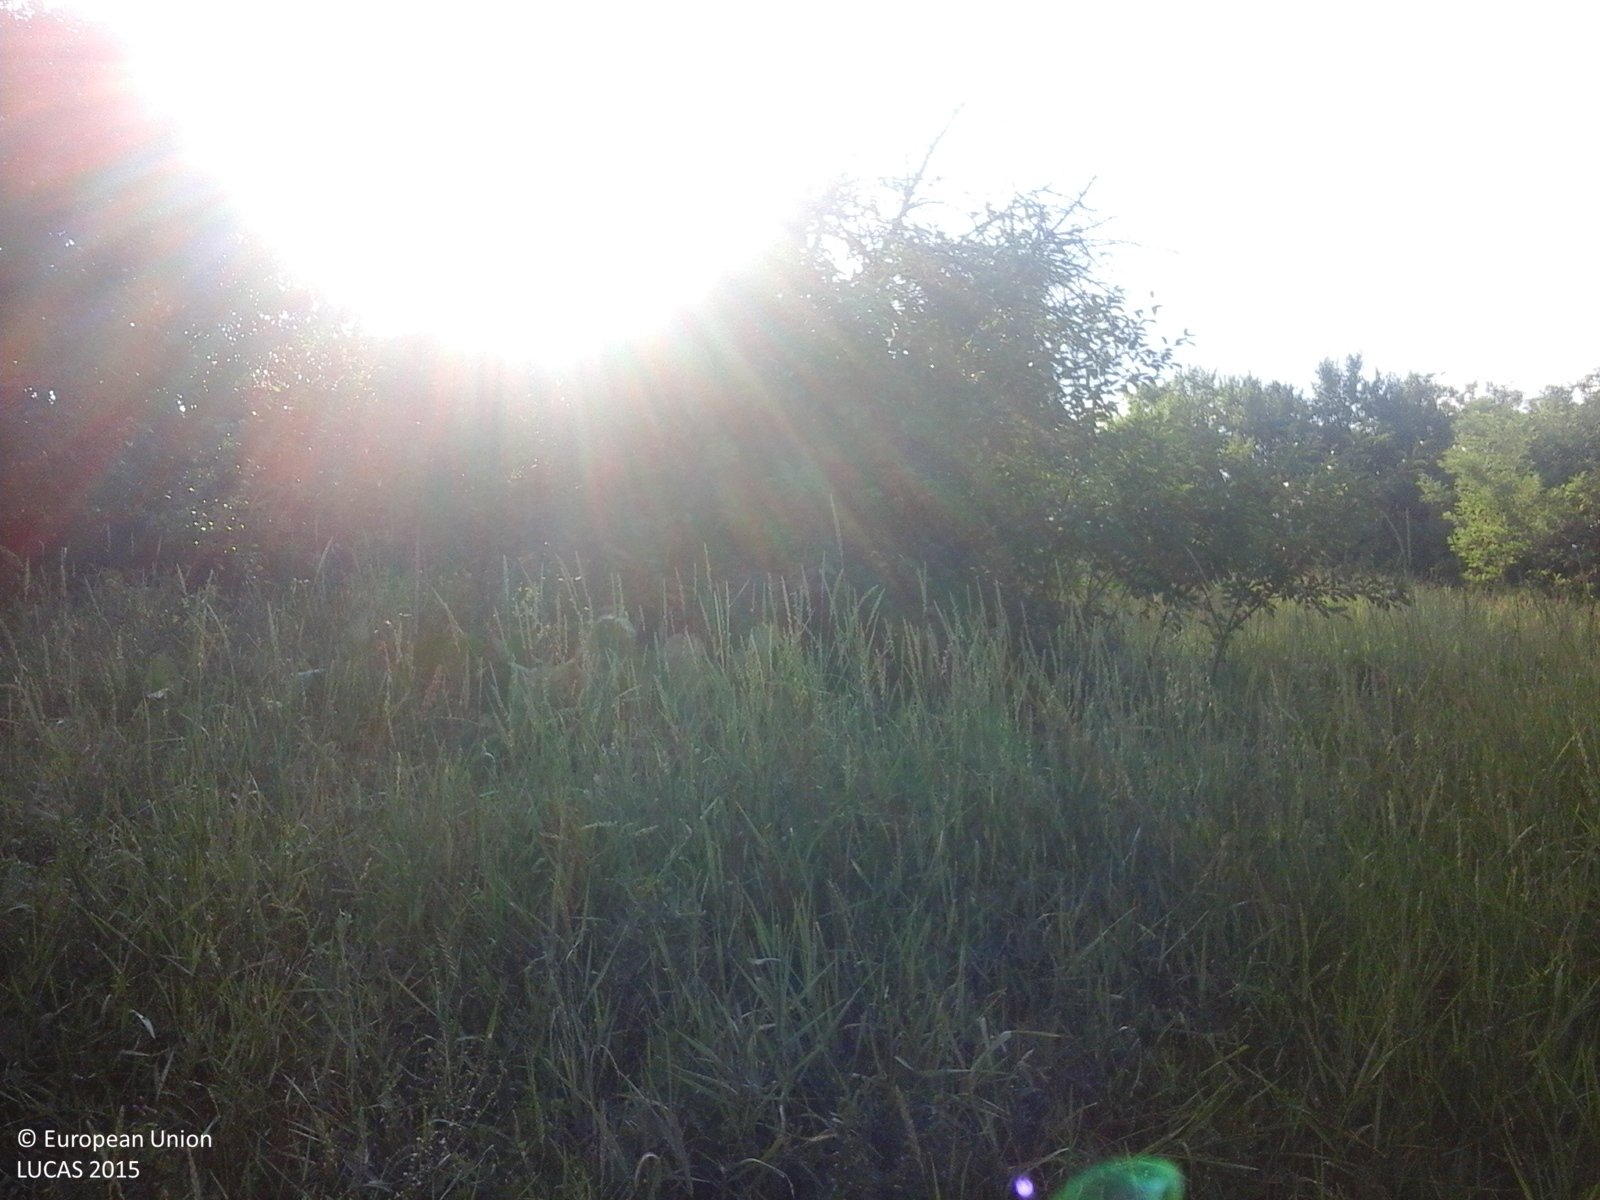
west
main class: Grassland
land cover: Grassland without tree/shrub cover
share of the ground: > 75 %
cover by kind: herbaceous plants 100 %
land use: Agriculture (excluding fallow land and kitchen gardens)
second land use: Residential
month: June
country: RO
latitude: 47.1618
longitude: 27.0255
